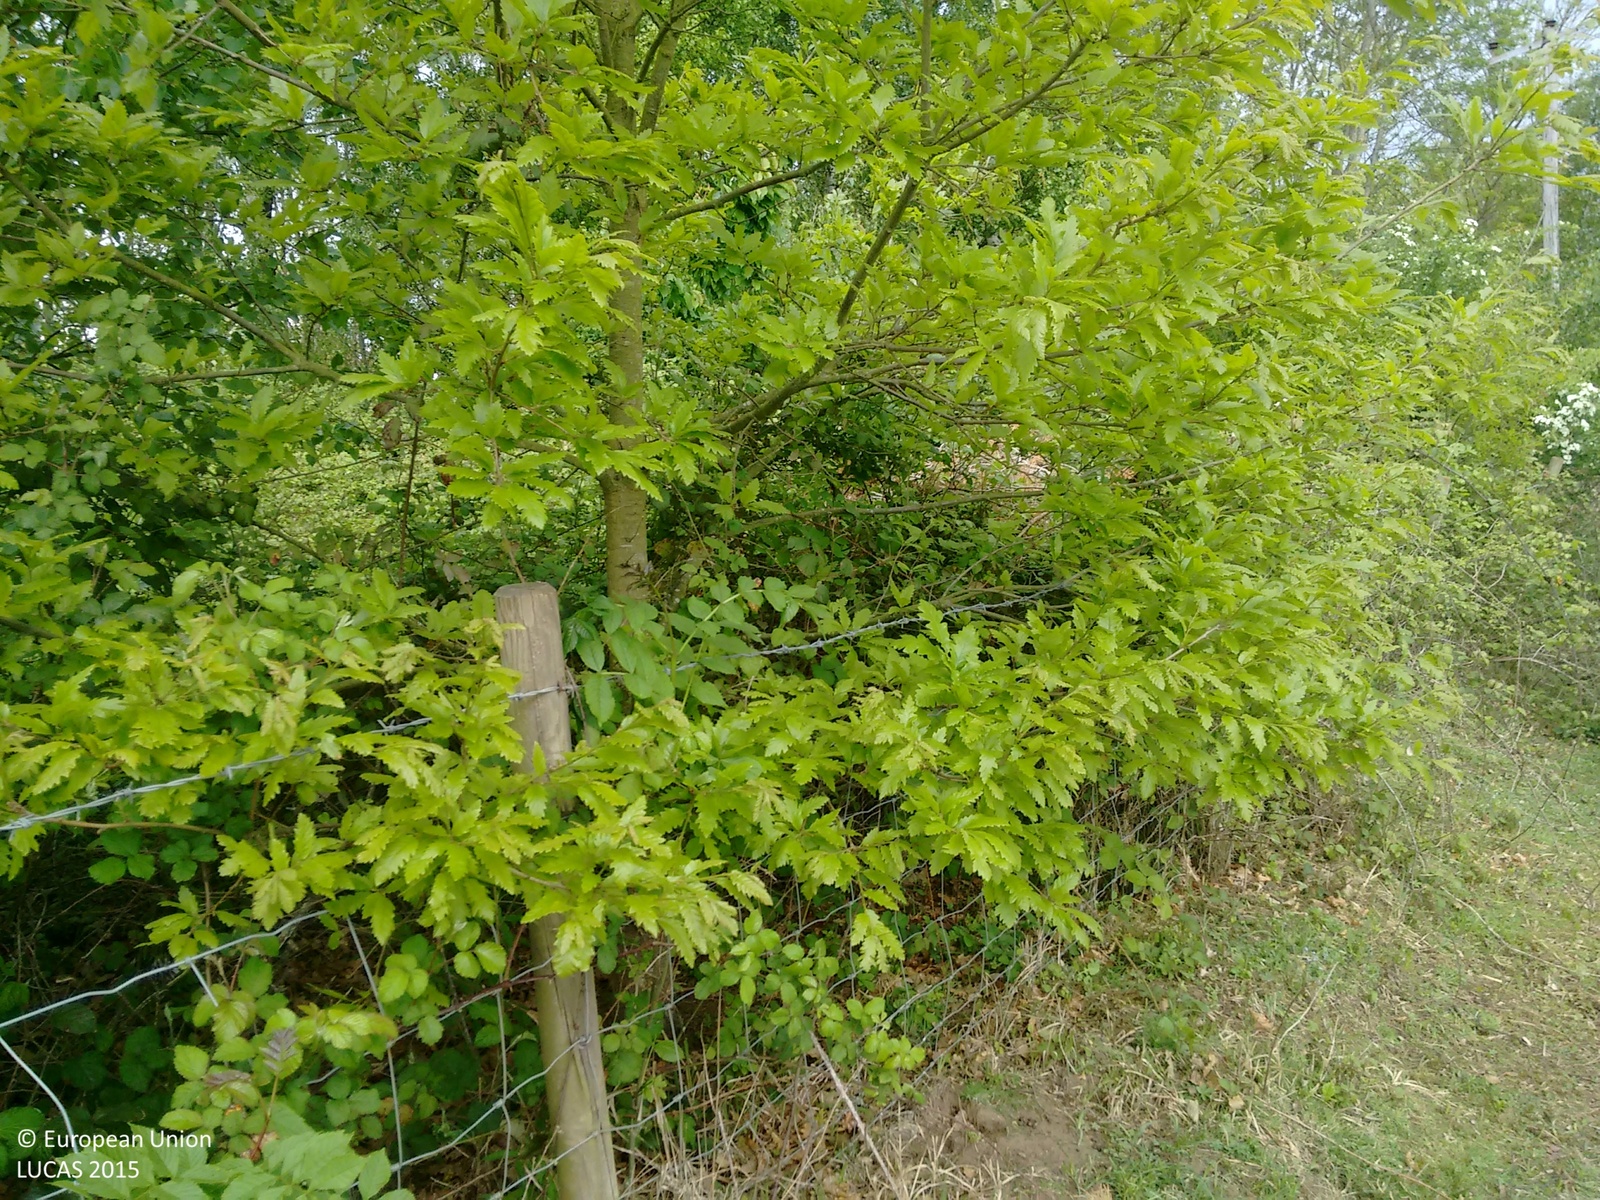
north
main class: Woodland
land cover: Broadleaved woodland
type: mesophytic deciduous forest
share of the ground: > 75 %
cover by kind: broadleaved forest trees 80 %, shrubs 20 %
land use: Semi-natural and natural areas not in use
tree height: > 5 m
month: May
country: GB
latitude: 51.2030
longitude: 0.7717
